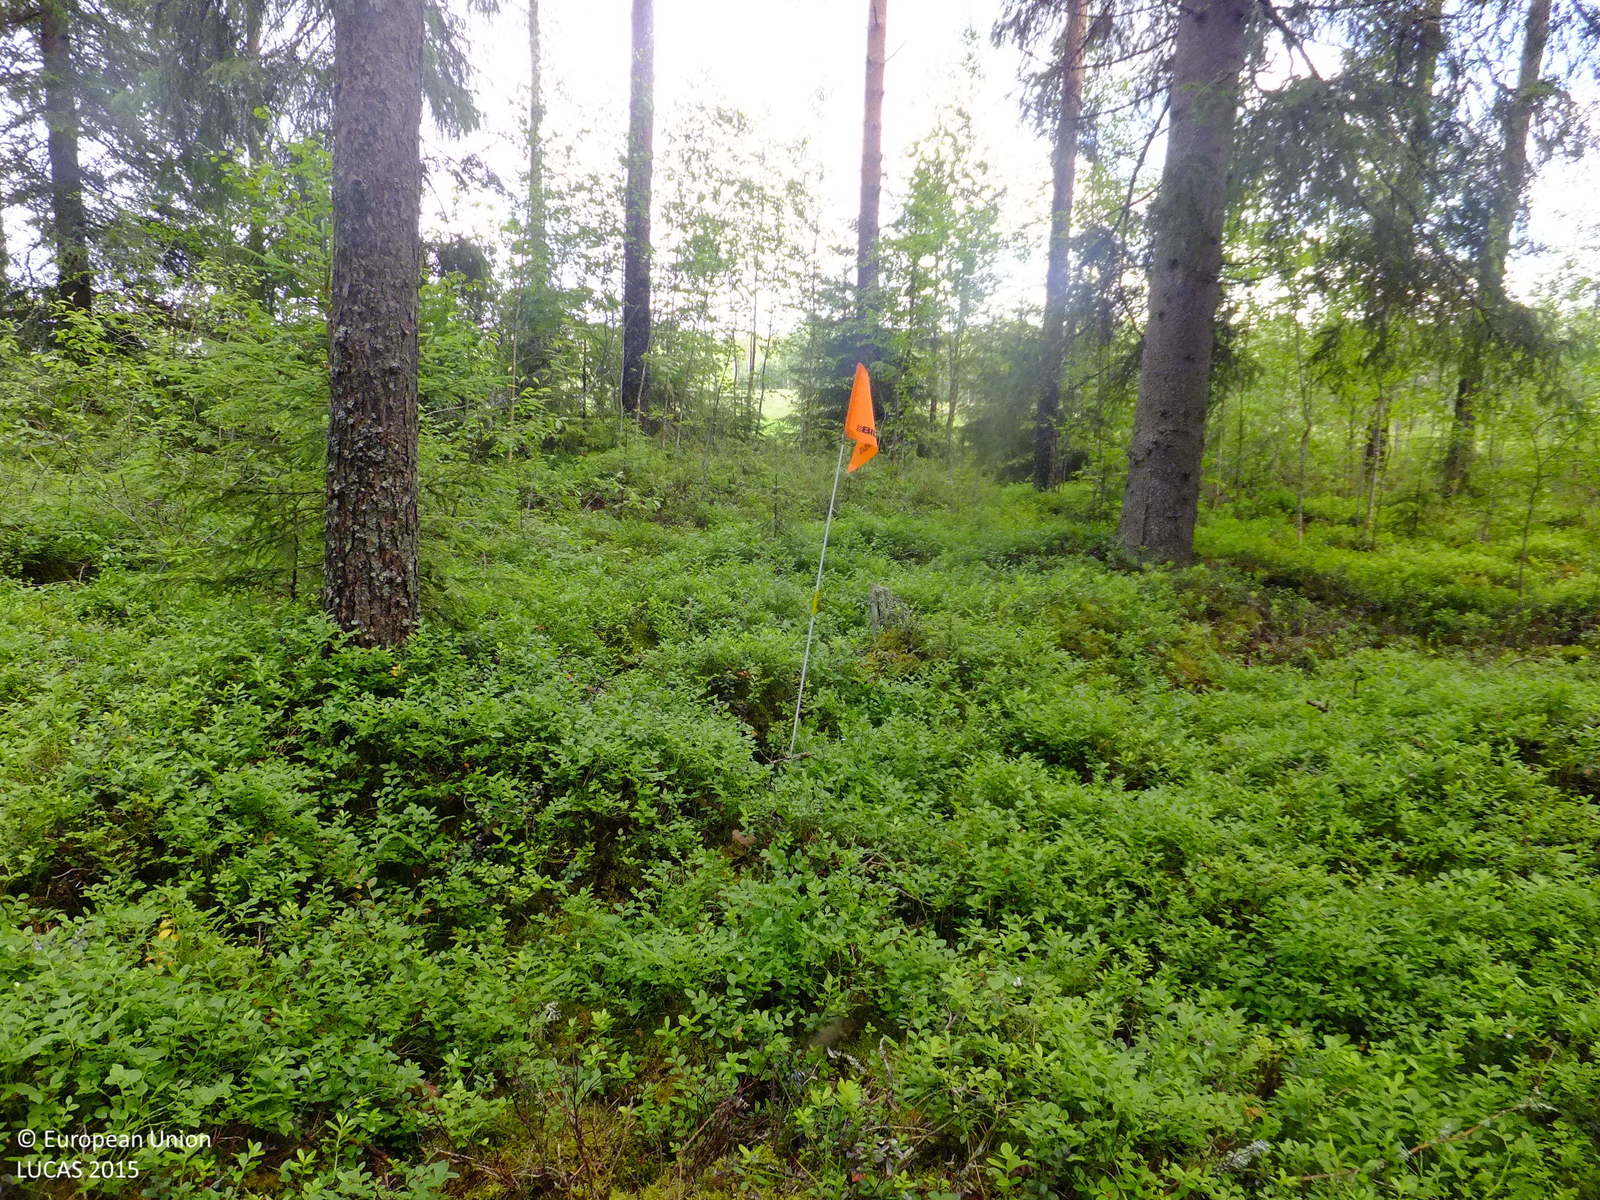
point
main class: Woodland
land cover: Other mixed woodland
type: boreal forest
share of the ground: > 75 %
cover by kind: broadleaved forest trees 50 %, coniferous forest trees 35 %, shrubs 10 %, herbaceous plants 5 %
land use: Forestry
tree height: > 5 m
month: July
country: FI
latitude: 63.0949
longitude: 24.5649
